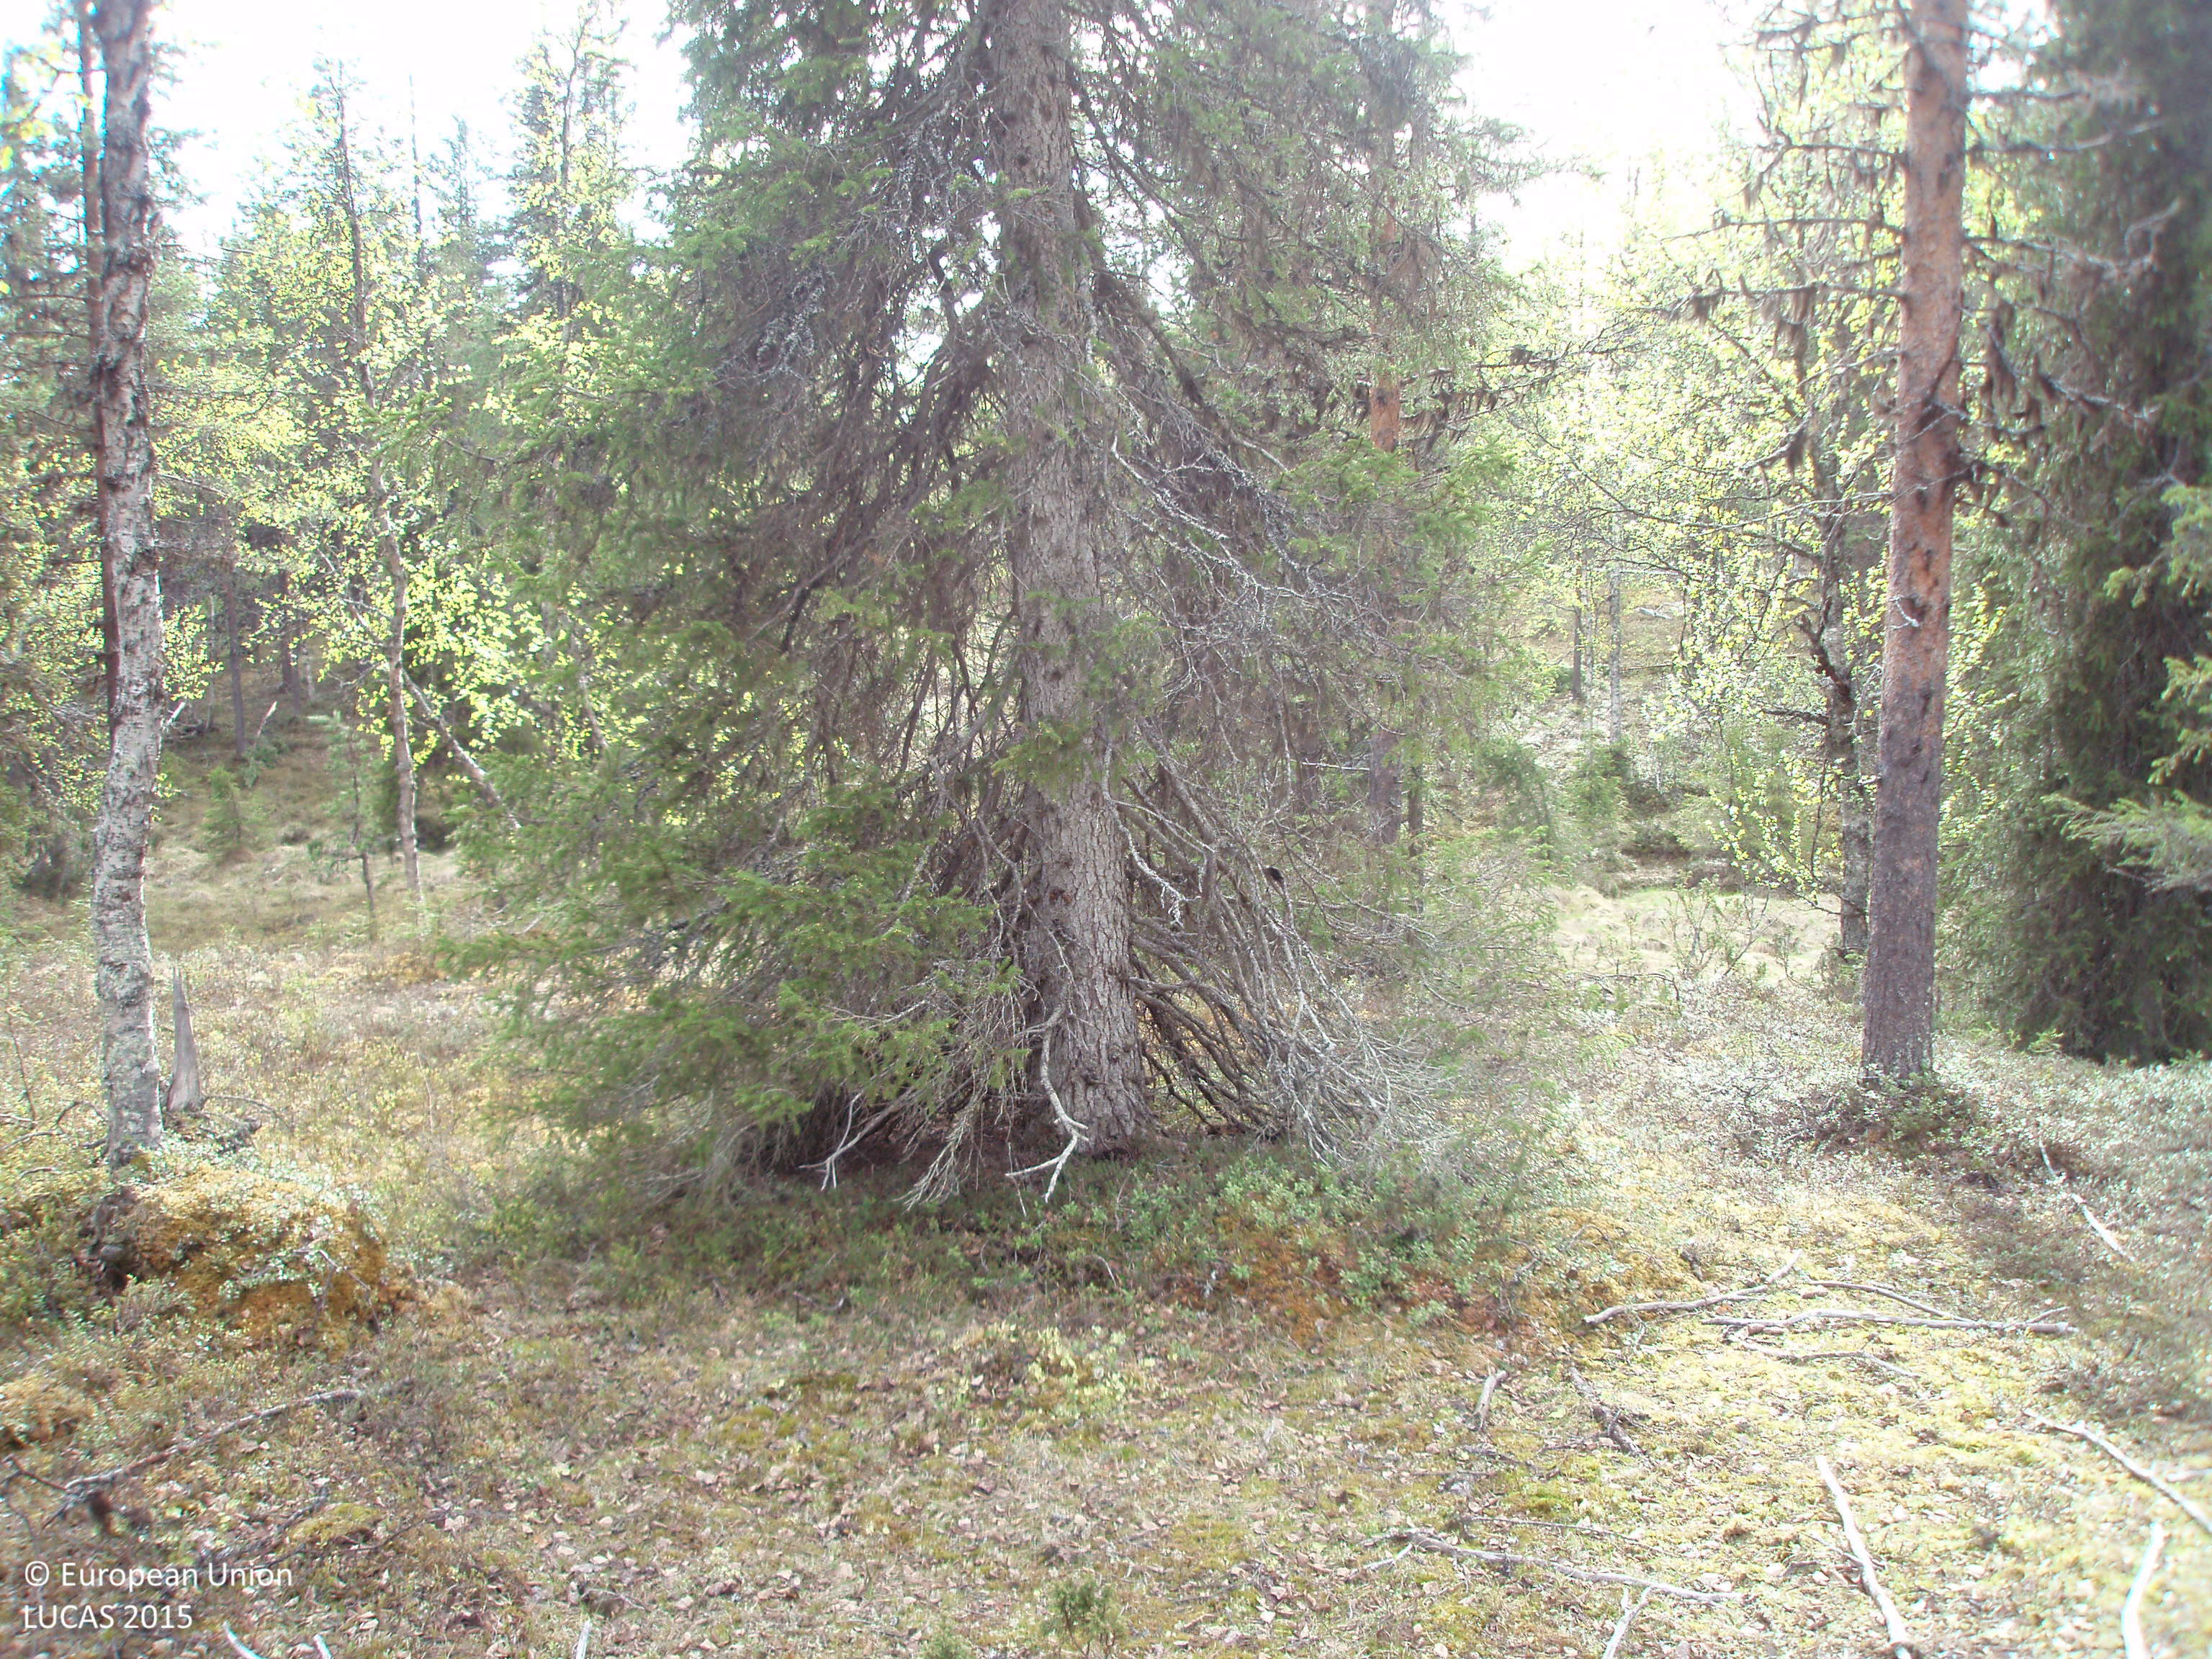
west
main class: Woodland
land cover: Other mixed woodland
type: boreal forest
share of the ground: 50 - 75 %
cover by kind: coniferous forest trees 50 %, broadleaved forest trees 20 %, shrubs 20 %, lichens and mosses 10 %
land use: Forestry
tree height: > 5 m
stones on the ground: 10 - 25 %
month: June
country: FI
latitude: 68.2769
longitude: 26.9936
